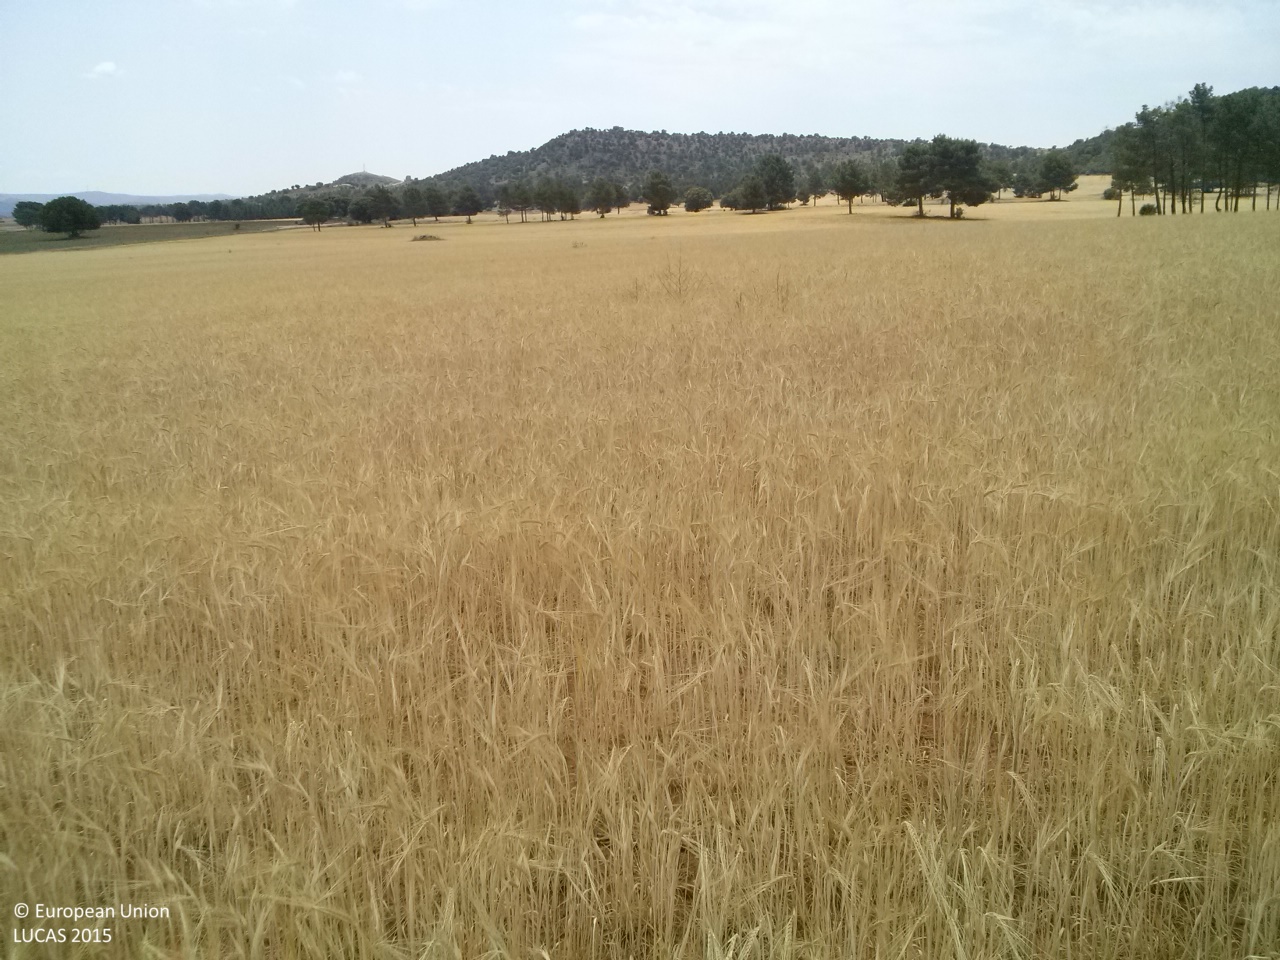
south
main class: Cropland
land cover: Barley
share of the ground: > 75 %
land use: Agriculture (excluding fallow land and kitchen gardens)
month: June
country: ES
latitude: 39.9724
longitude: -1.8023
